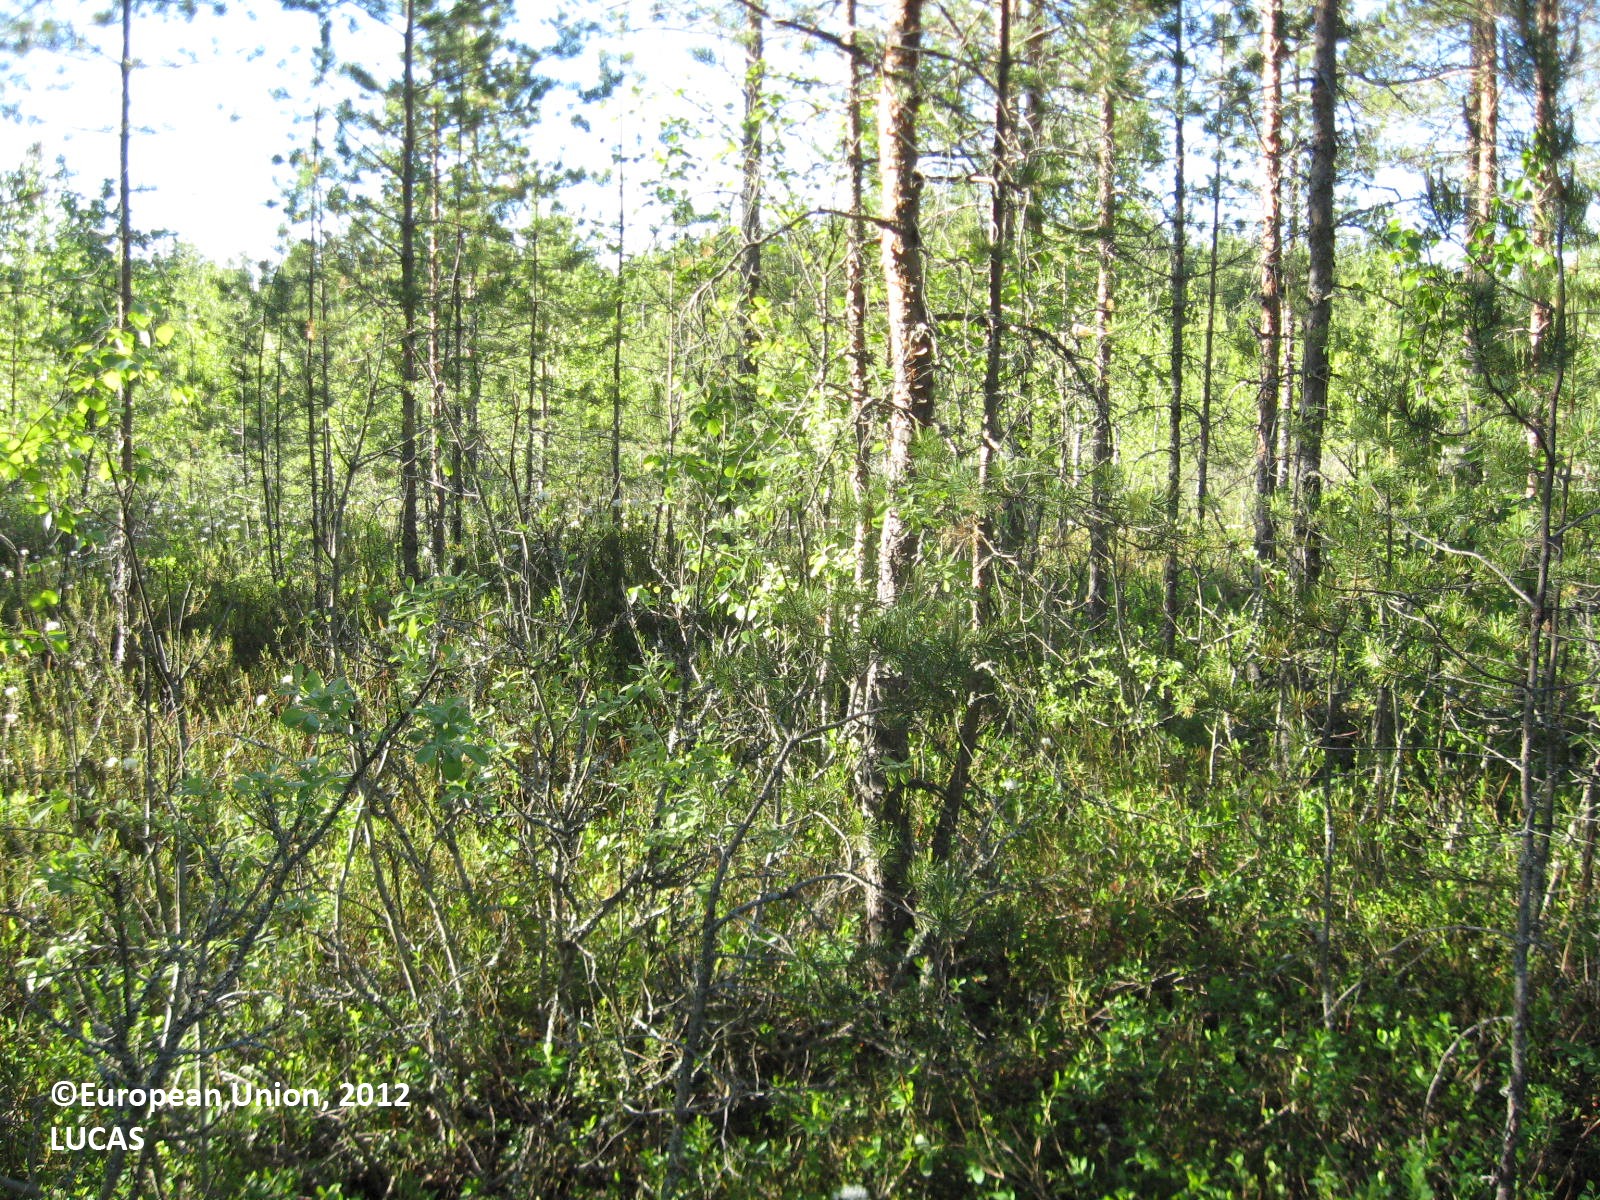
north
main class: Woodland
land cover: Pine dominated coniferous woodland
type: boreal forest
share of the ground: > 75 %
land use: Forestry
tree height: > 5 m
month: June
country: FI
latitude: 62.8584
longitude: 21.5752
